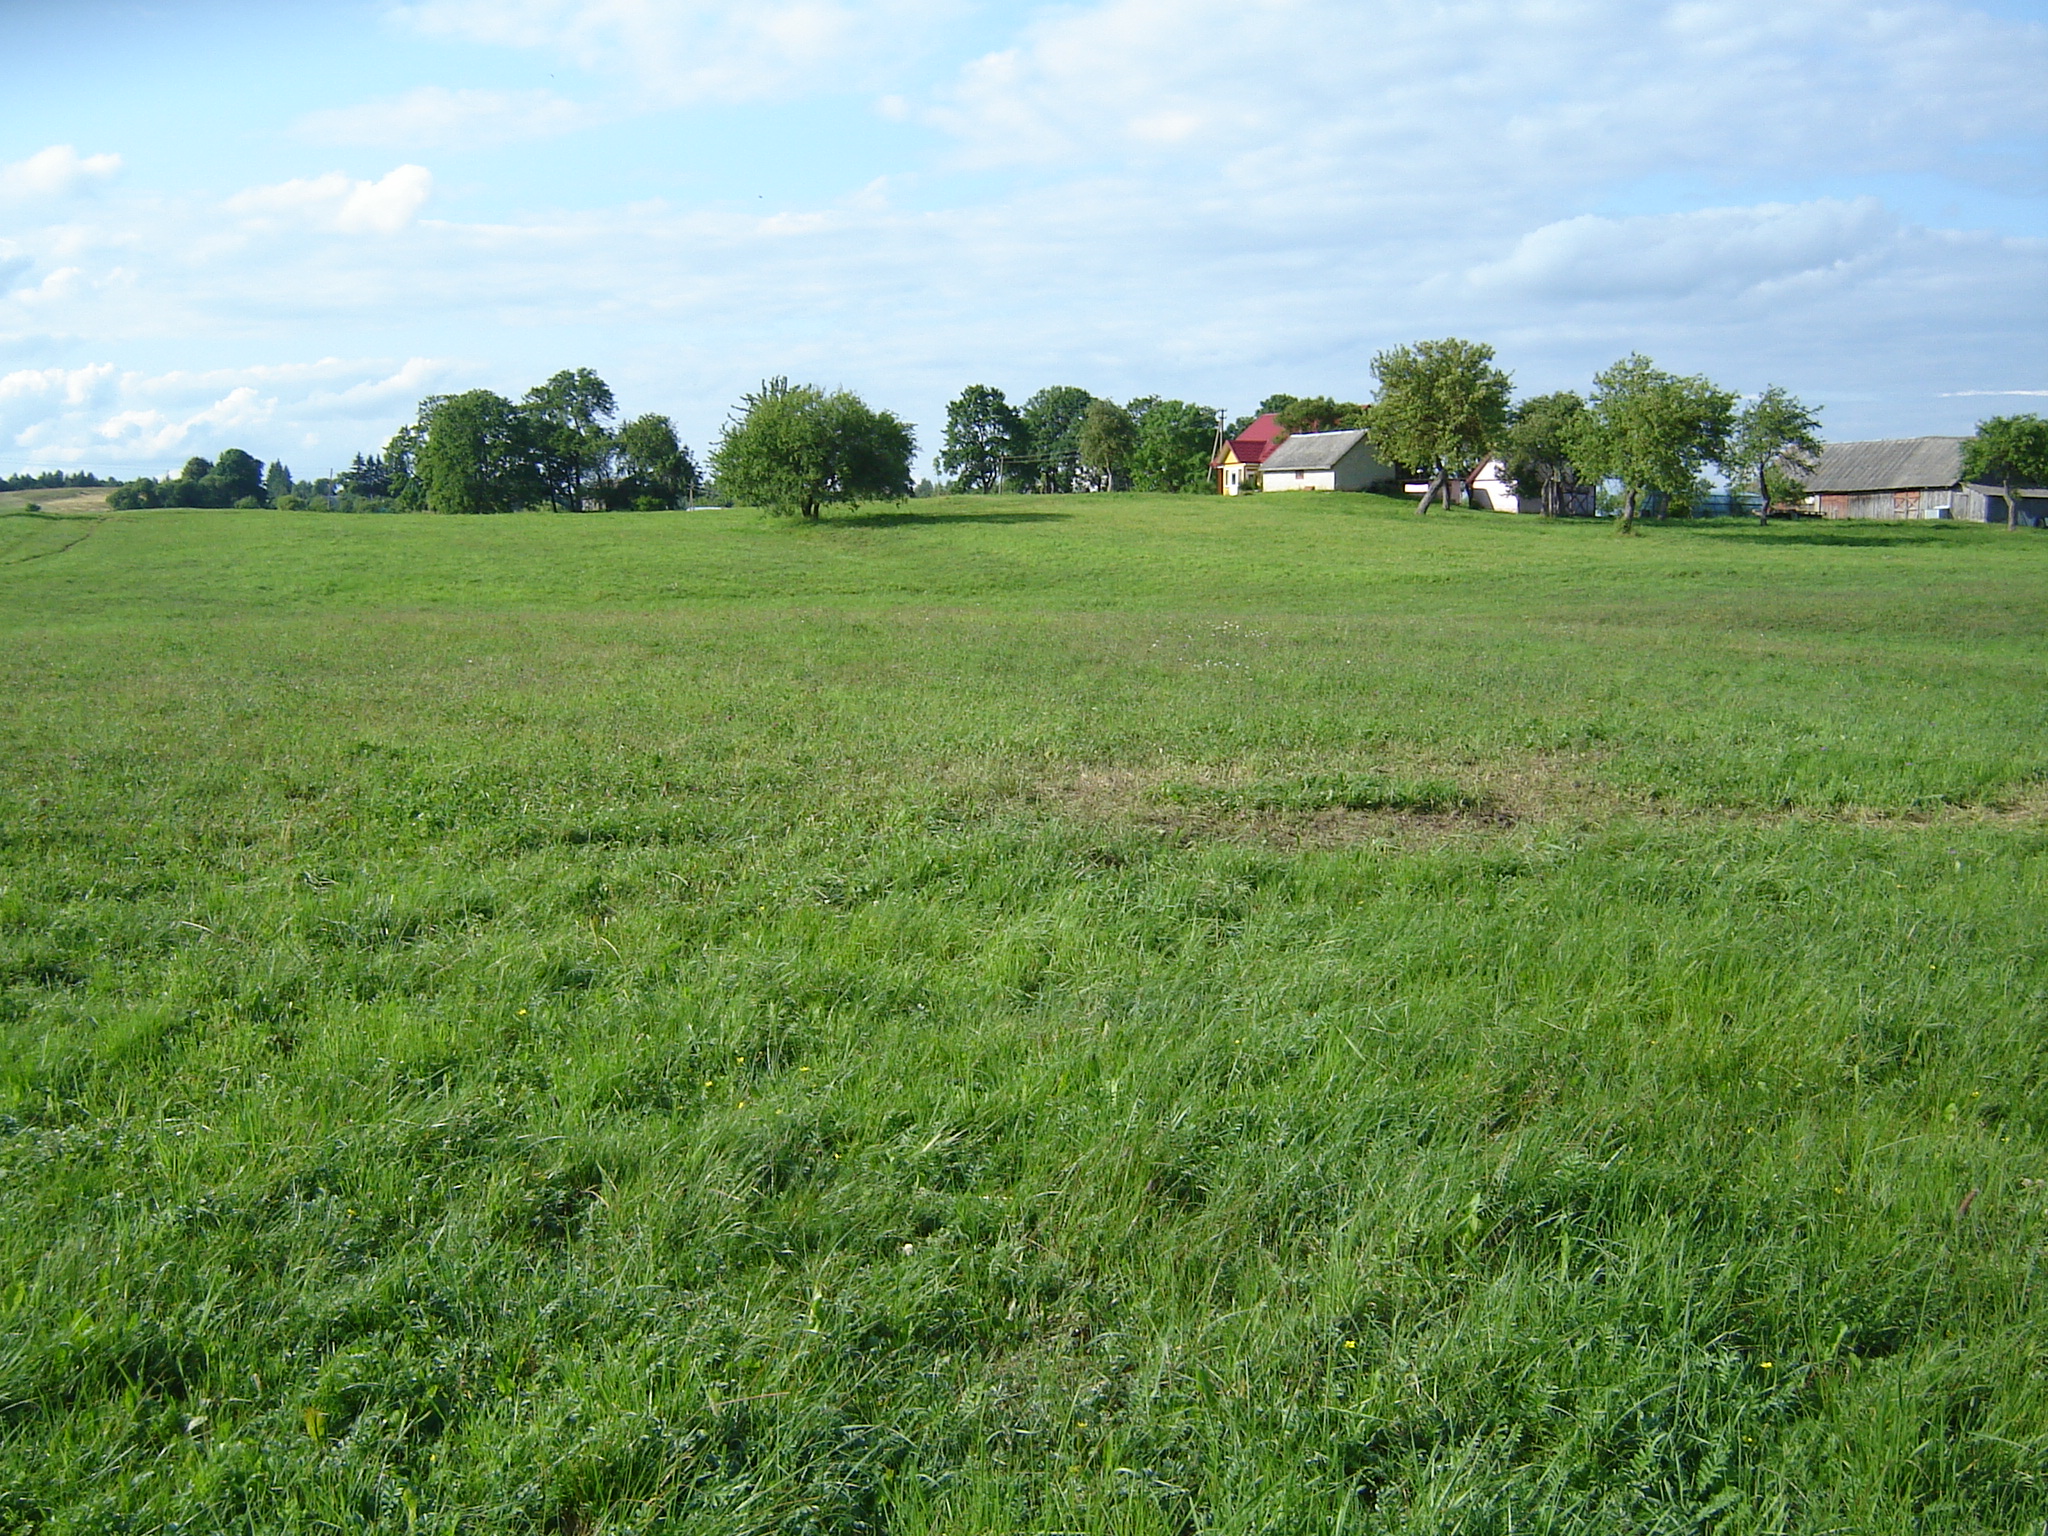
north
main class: Grassland
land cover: Grassland without tree/shrub cover
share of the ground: > 75 %
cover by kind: herbaceous plants 100 %
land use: Agriculture (excluding fallow land and kitchen gardens)
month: July
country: LT
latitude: 55.3125
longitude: 25.4866
